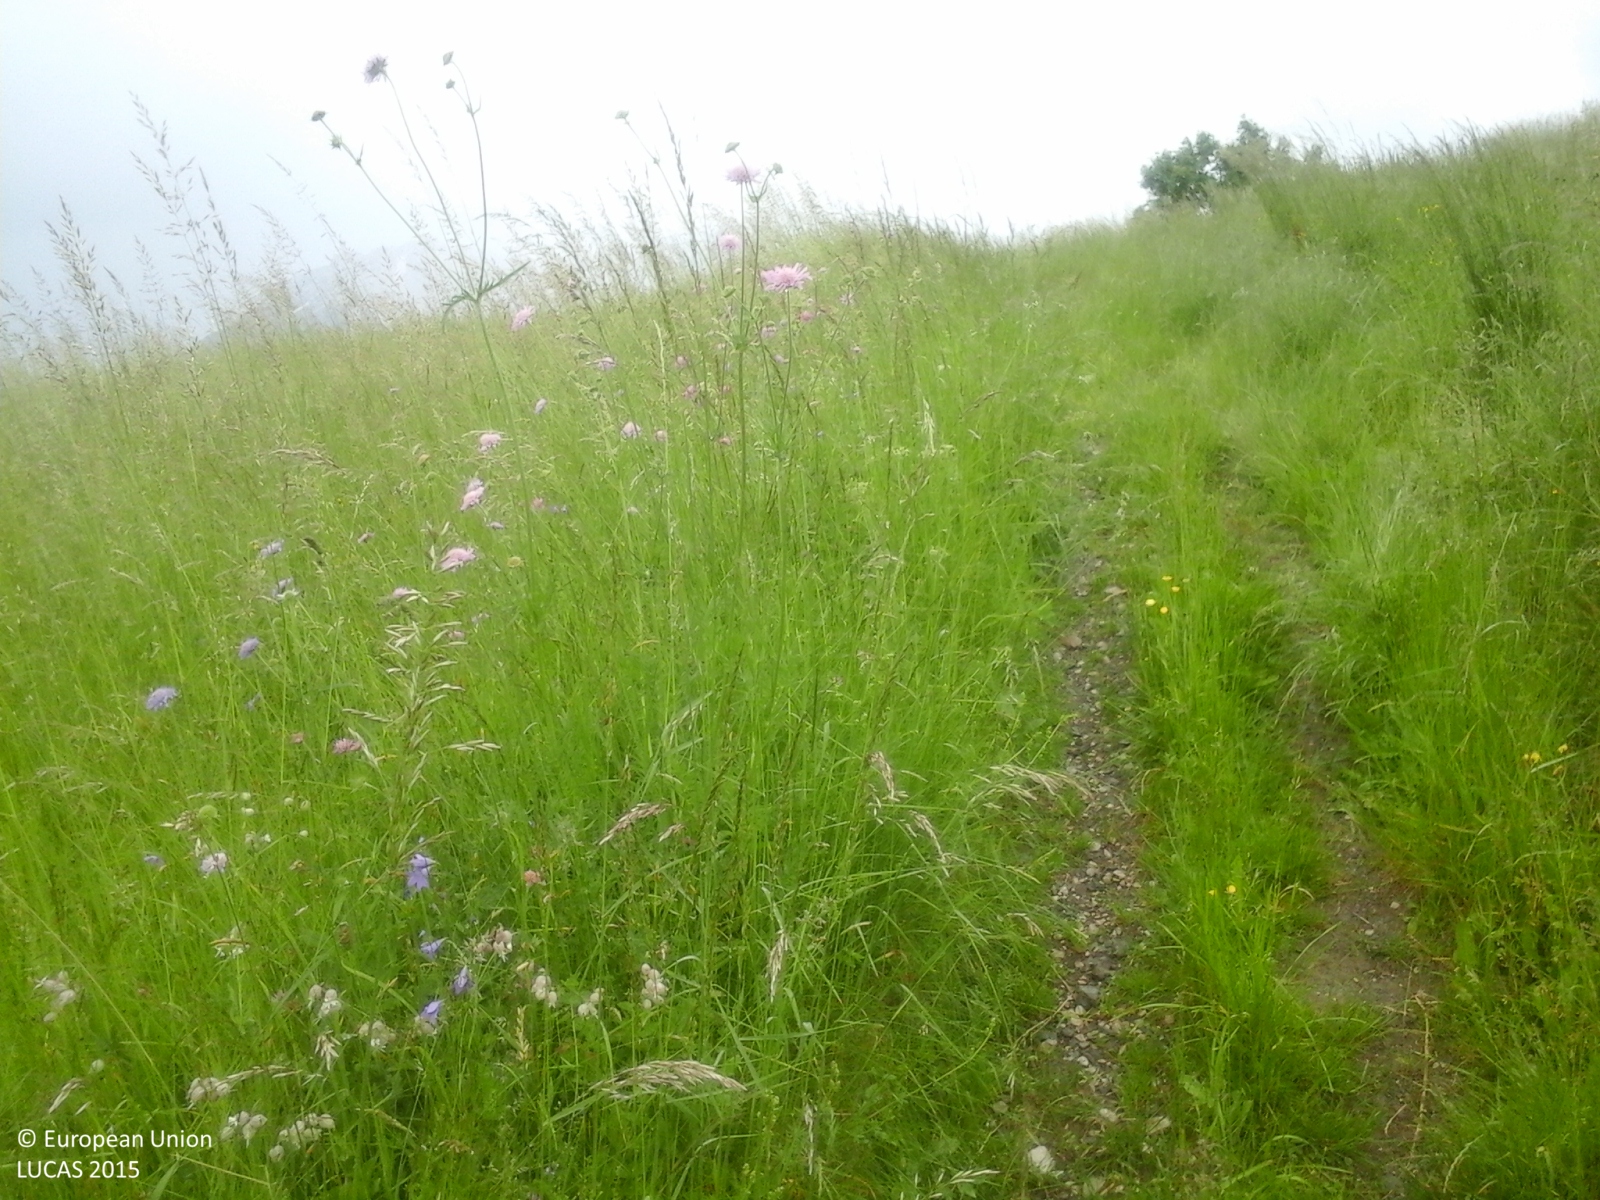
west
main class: Grassland
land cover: Grassland without tree/shrub cover
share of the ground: > 75 %
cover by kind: herbaceous plants 100 %
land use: Agriculture (excluding fallow land and kitchen gardens)
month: June
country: IT
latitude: 46.5919
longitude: 12.5165
